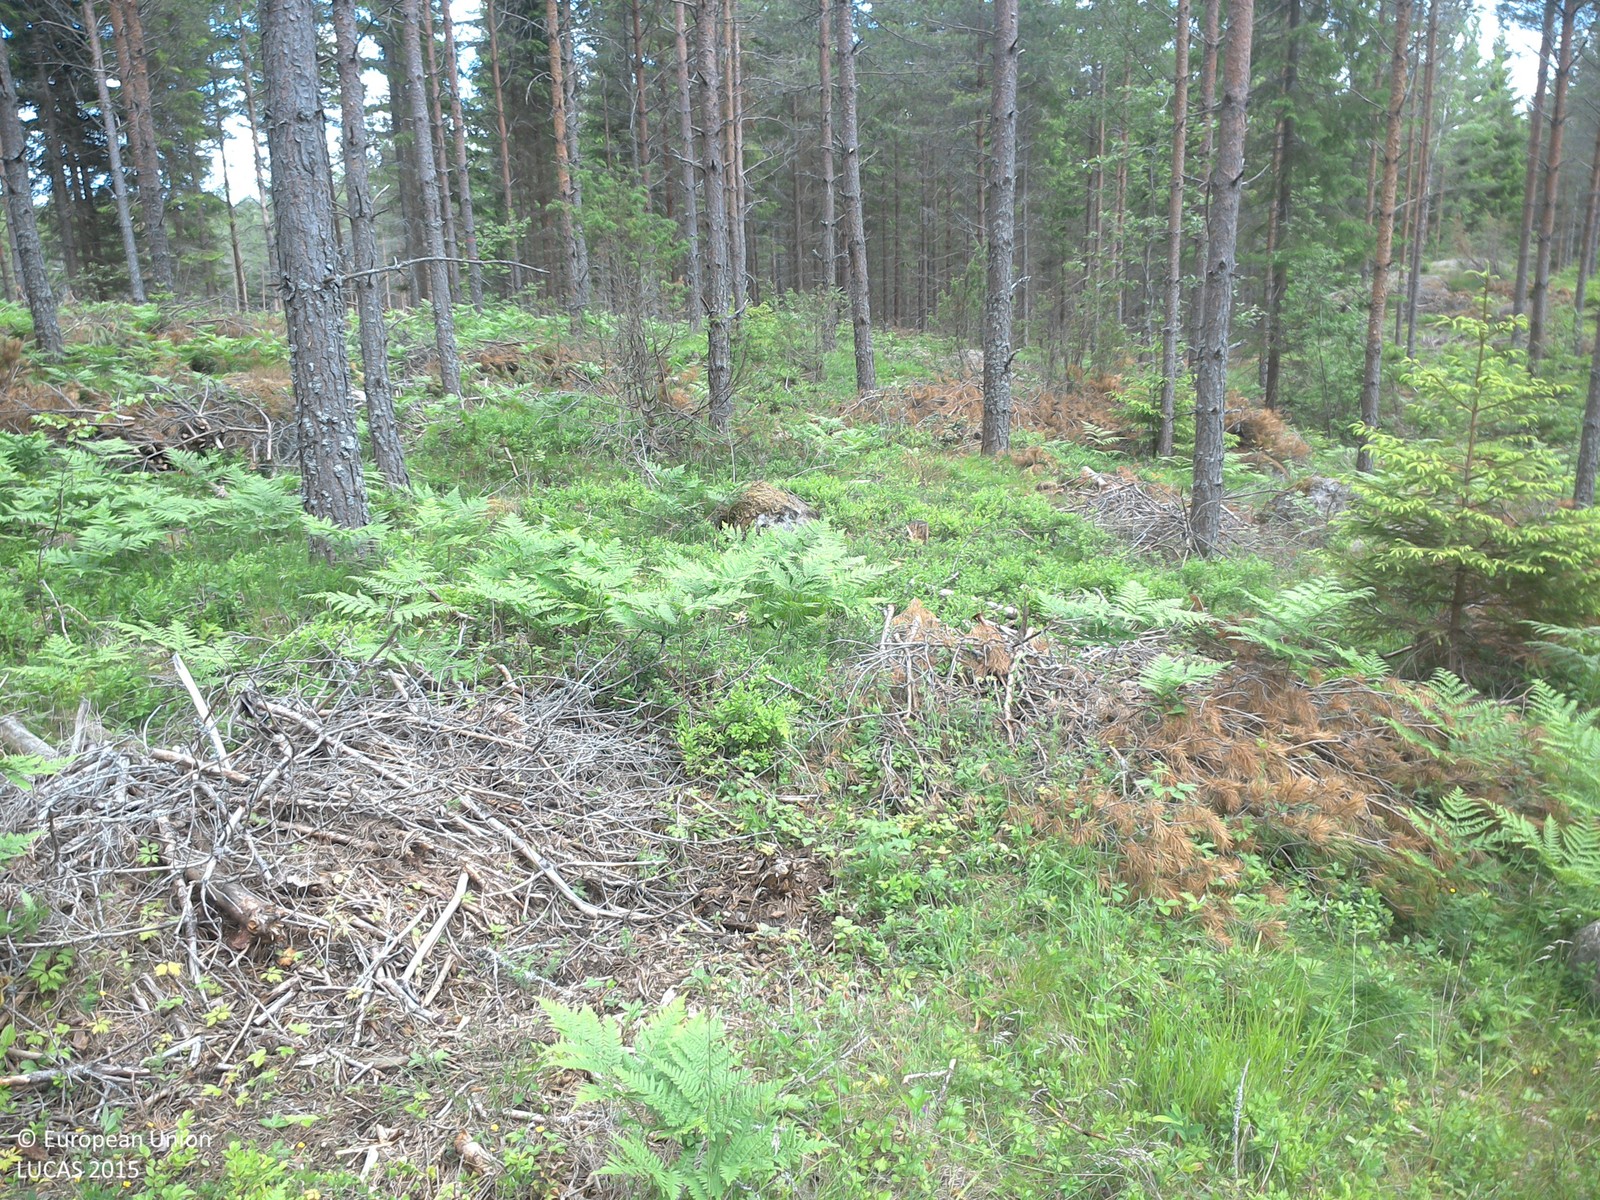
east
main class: Woodland
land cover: Pine dominated coniferous woodland
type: boreal forest
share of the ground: 50 - 75 %
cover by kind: coniferous forest trees 65 %, herbaceous plants 30 %, lichens and mosses 5 %
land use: Forestry
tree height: > 5 m
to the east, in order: Pine dominated coniferous woodland; Spruce dominated coniferous woodland; Pine dominated coniferous woodland; Spruce dominated coniferous woodland; Grassland with sparse tree/shrub cover; Pine dominated mixed woodland; Spruce dominated coniferous woodland; Pine dominated coniferous woodland
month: June
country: SE
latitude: 57.9774
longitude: 15.9991
